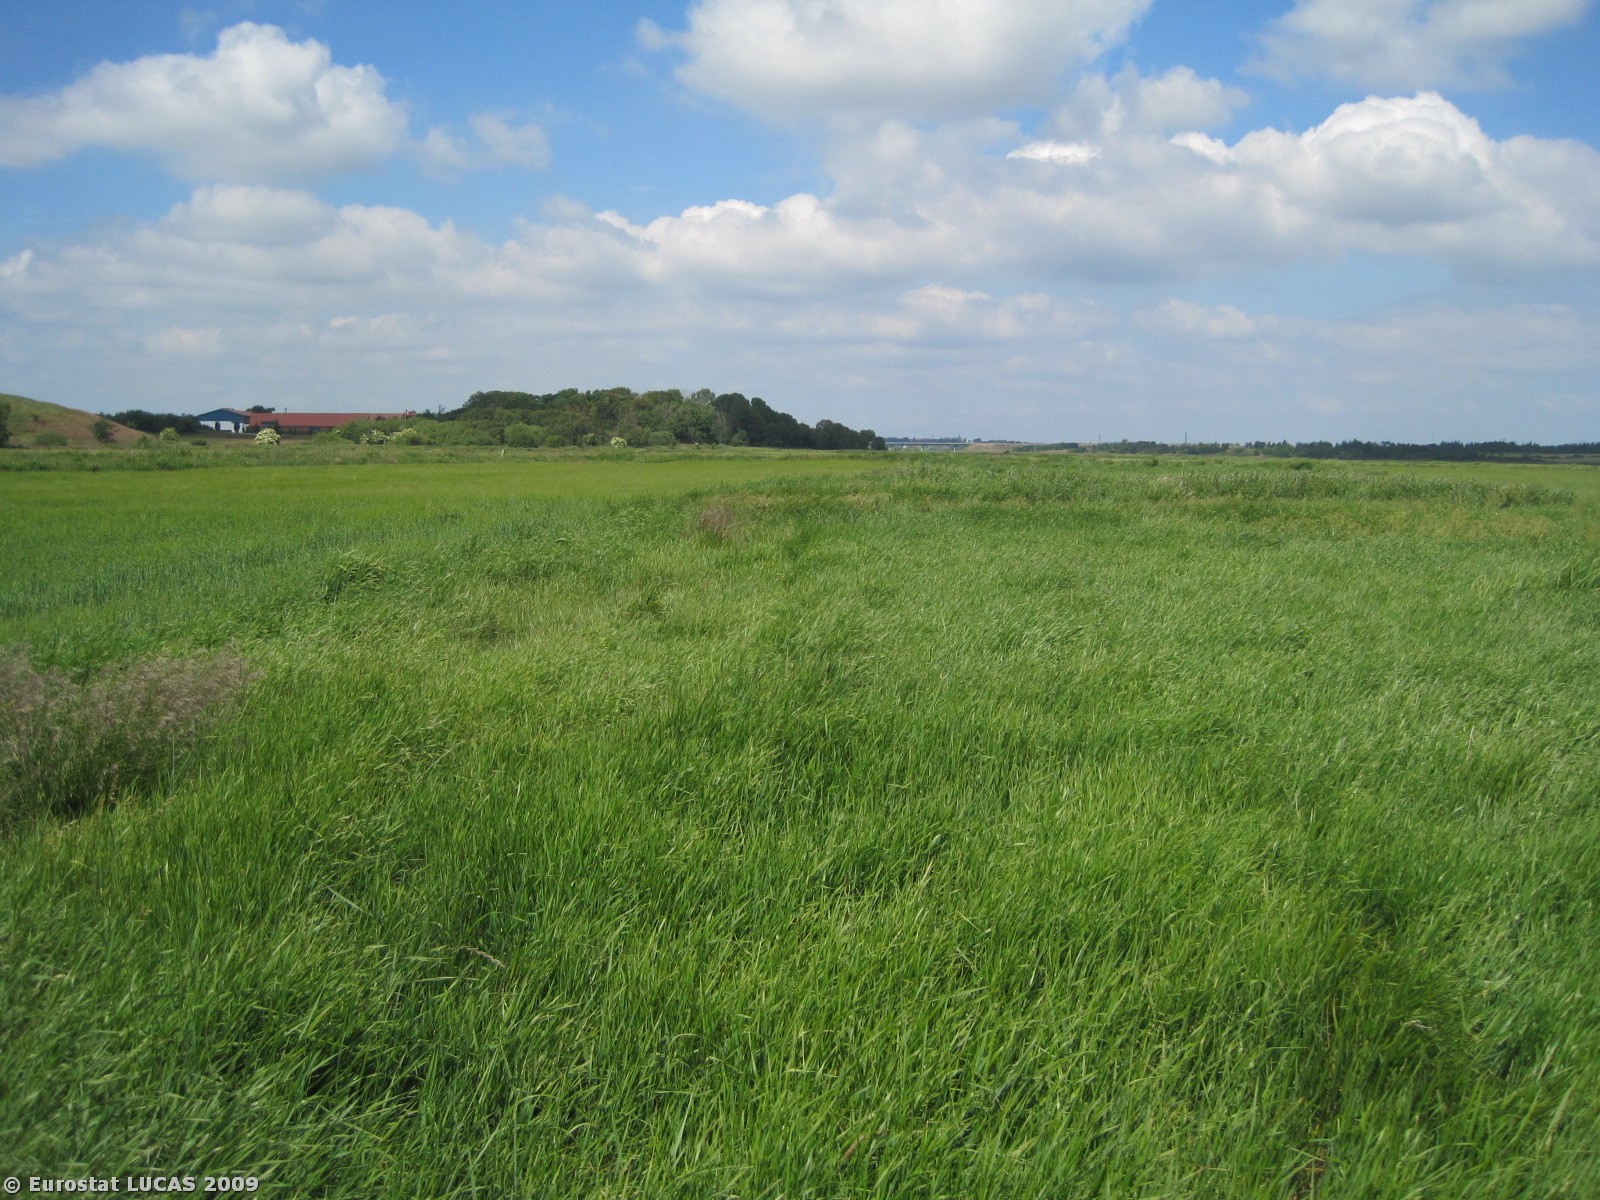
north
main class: Grassland
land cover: Grassland without tree/shrub cover
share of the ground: > 75 %
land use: Agriculture (excluding fallow land and kitchen gardens)
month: June
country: DK
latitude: 56.5252
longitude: 8.9772
